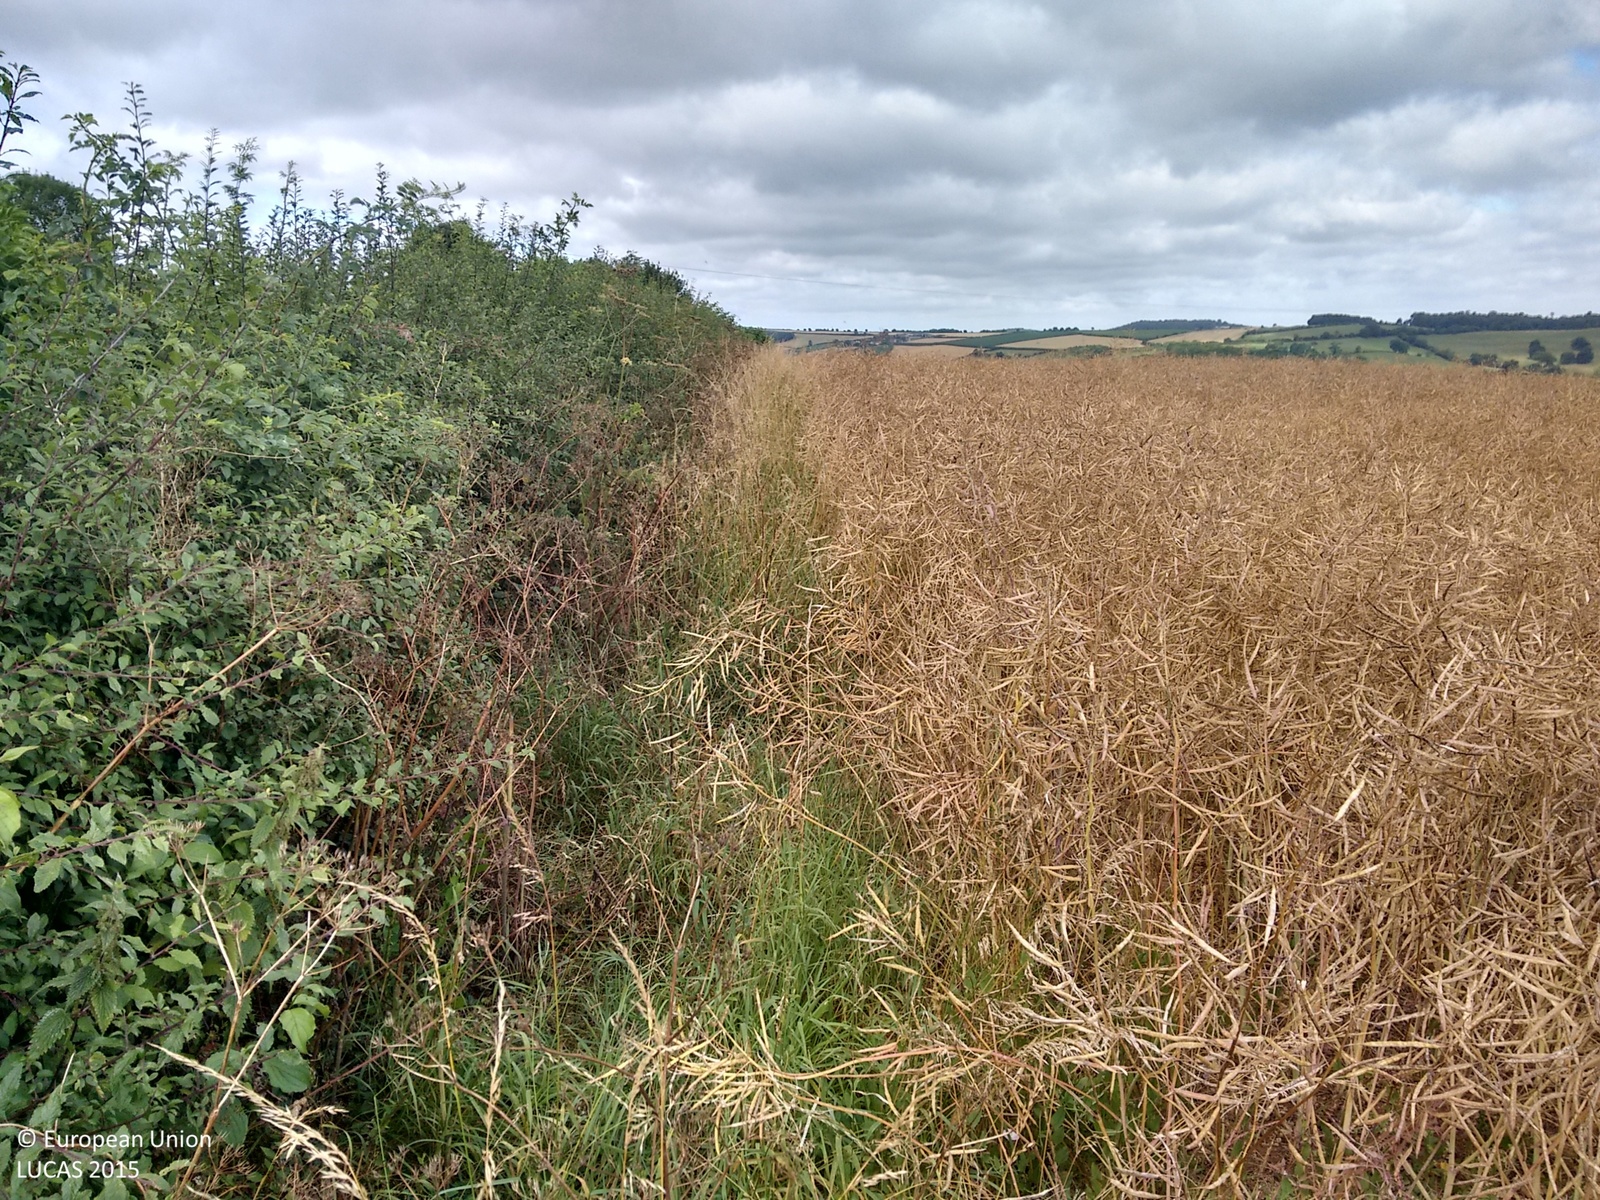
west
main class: Cropland
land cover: Rape and turnip rape
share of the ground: > 75 %
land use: Agriculture (excluding fallow land and kitchen gardens)
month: July
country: GB
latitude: 51.3601
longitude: -2.4013
